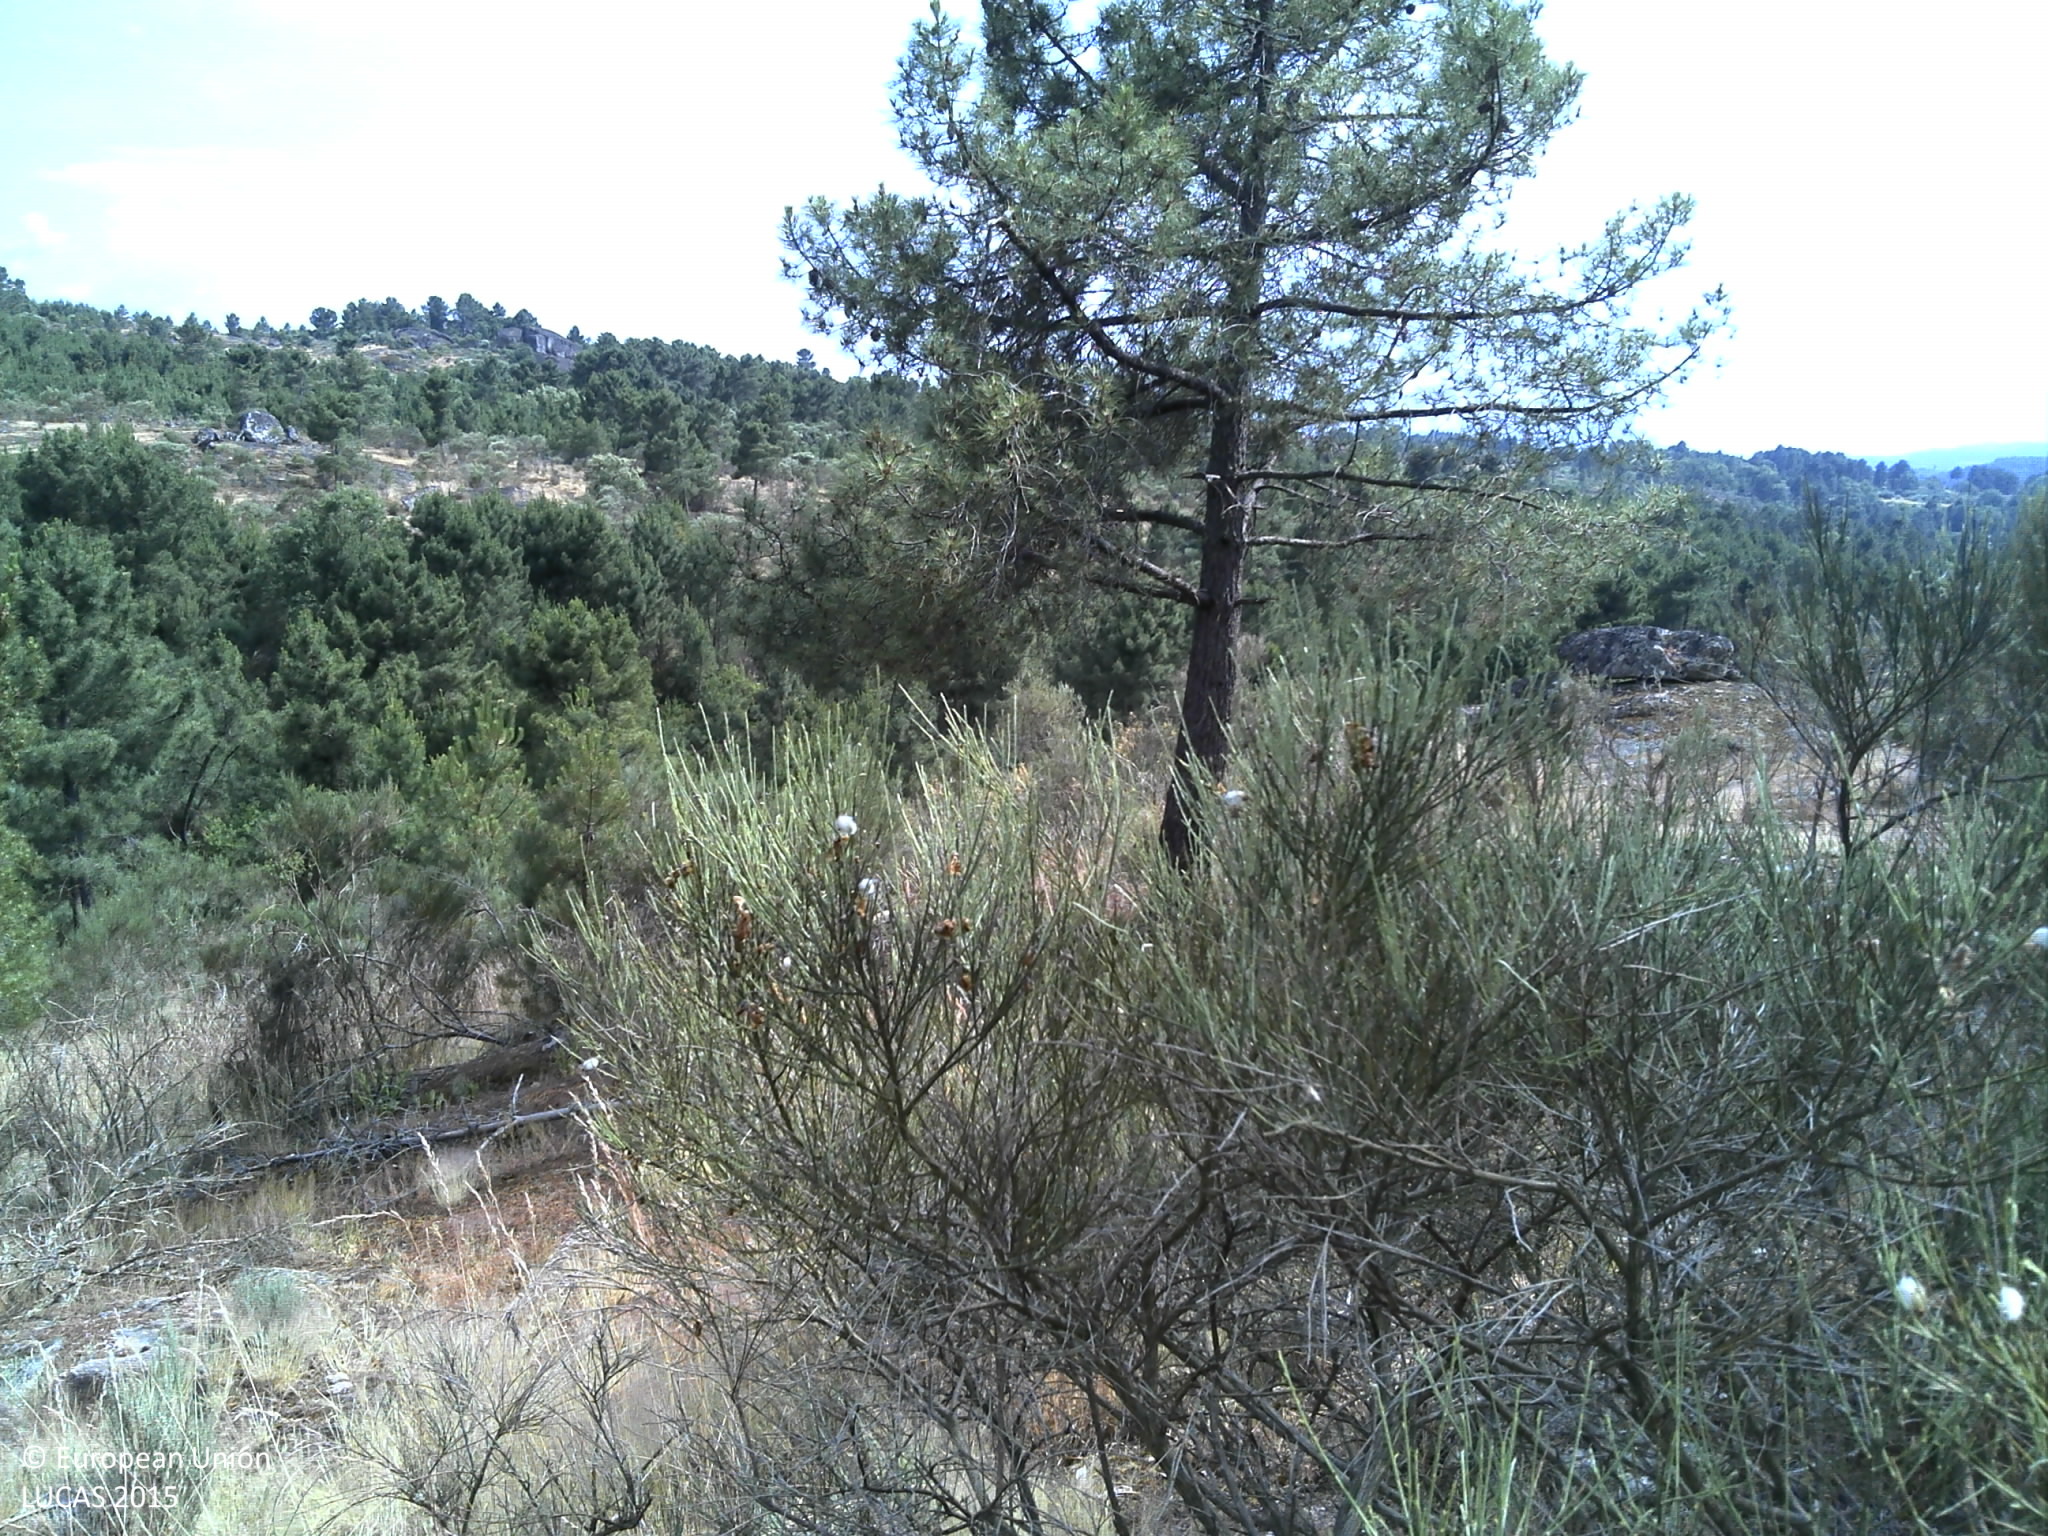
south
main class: Shrubland
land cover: Shrubland with sparse tree cover
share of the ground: > 75 %
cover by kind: shrubs 55 %, herbaceous plants 30 %, consolidated bare surface 10 %, coniferous forest trees 5 %
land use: Semi-natural and natural areas not in use
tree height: > 5 m
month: June
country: PT
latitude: 41.3106
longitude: -7.6512
